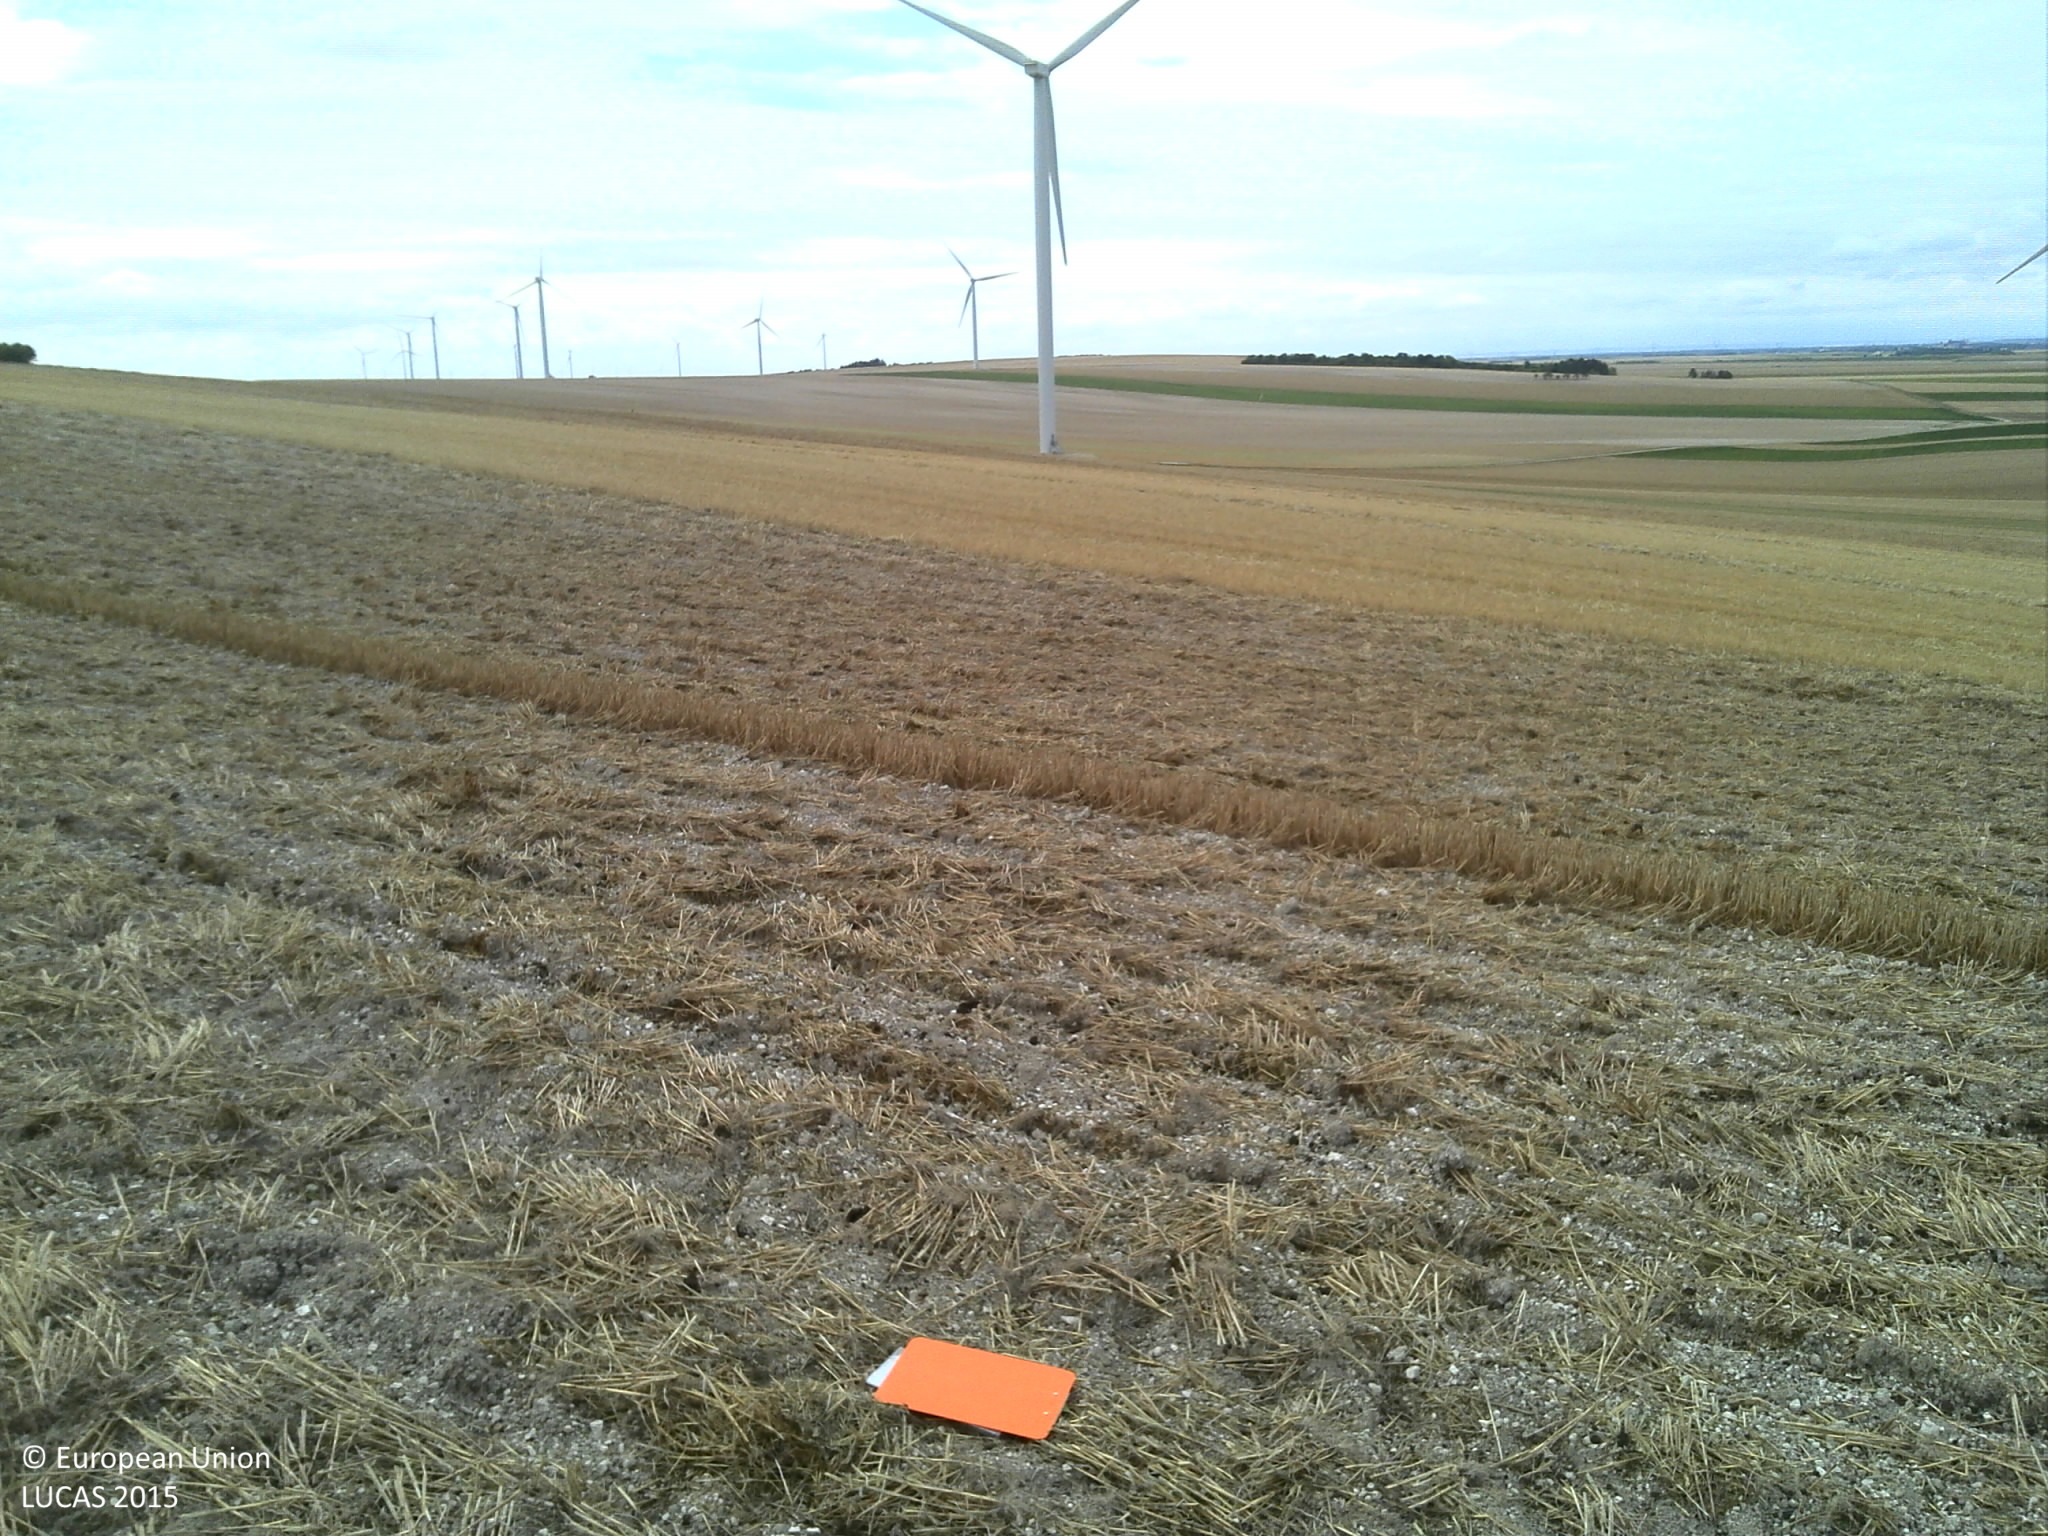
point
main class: Cropland
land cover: Common wheat
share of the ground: 25 - 50 %
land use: Agriculture (excluding fallow land and kitchen gardens)
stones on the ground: 10 - 25 %
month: August
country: FR
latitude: 48.4882
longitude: 4.2461
